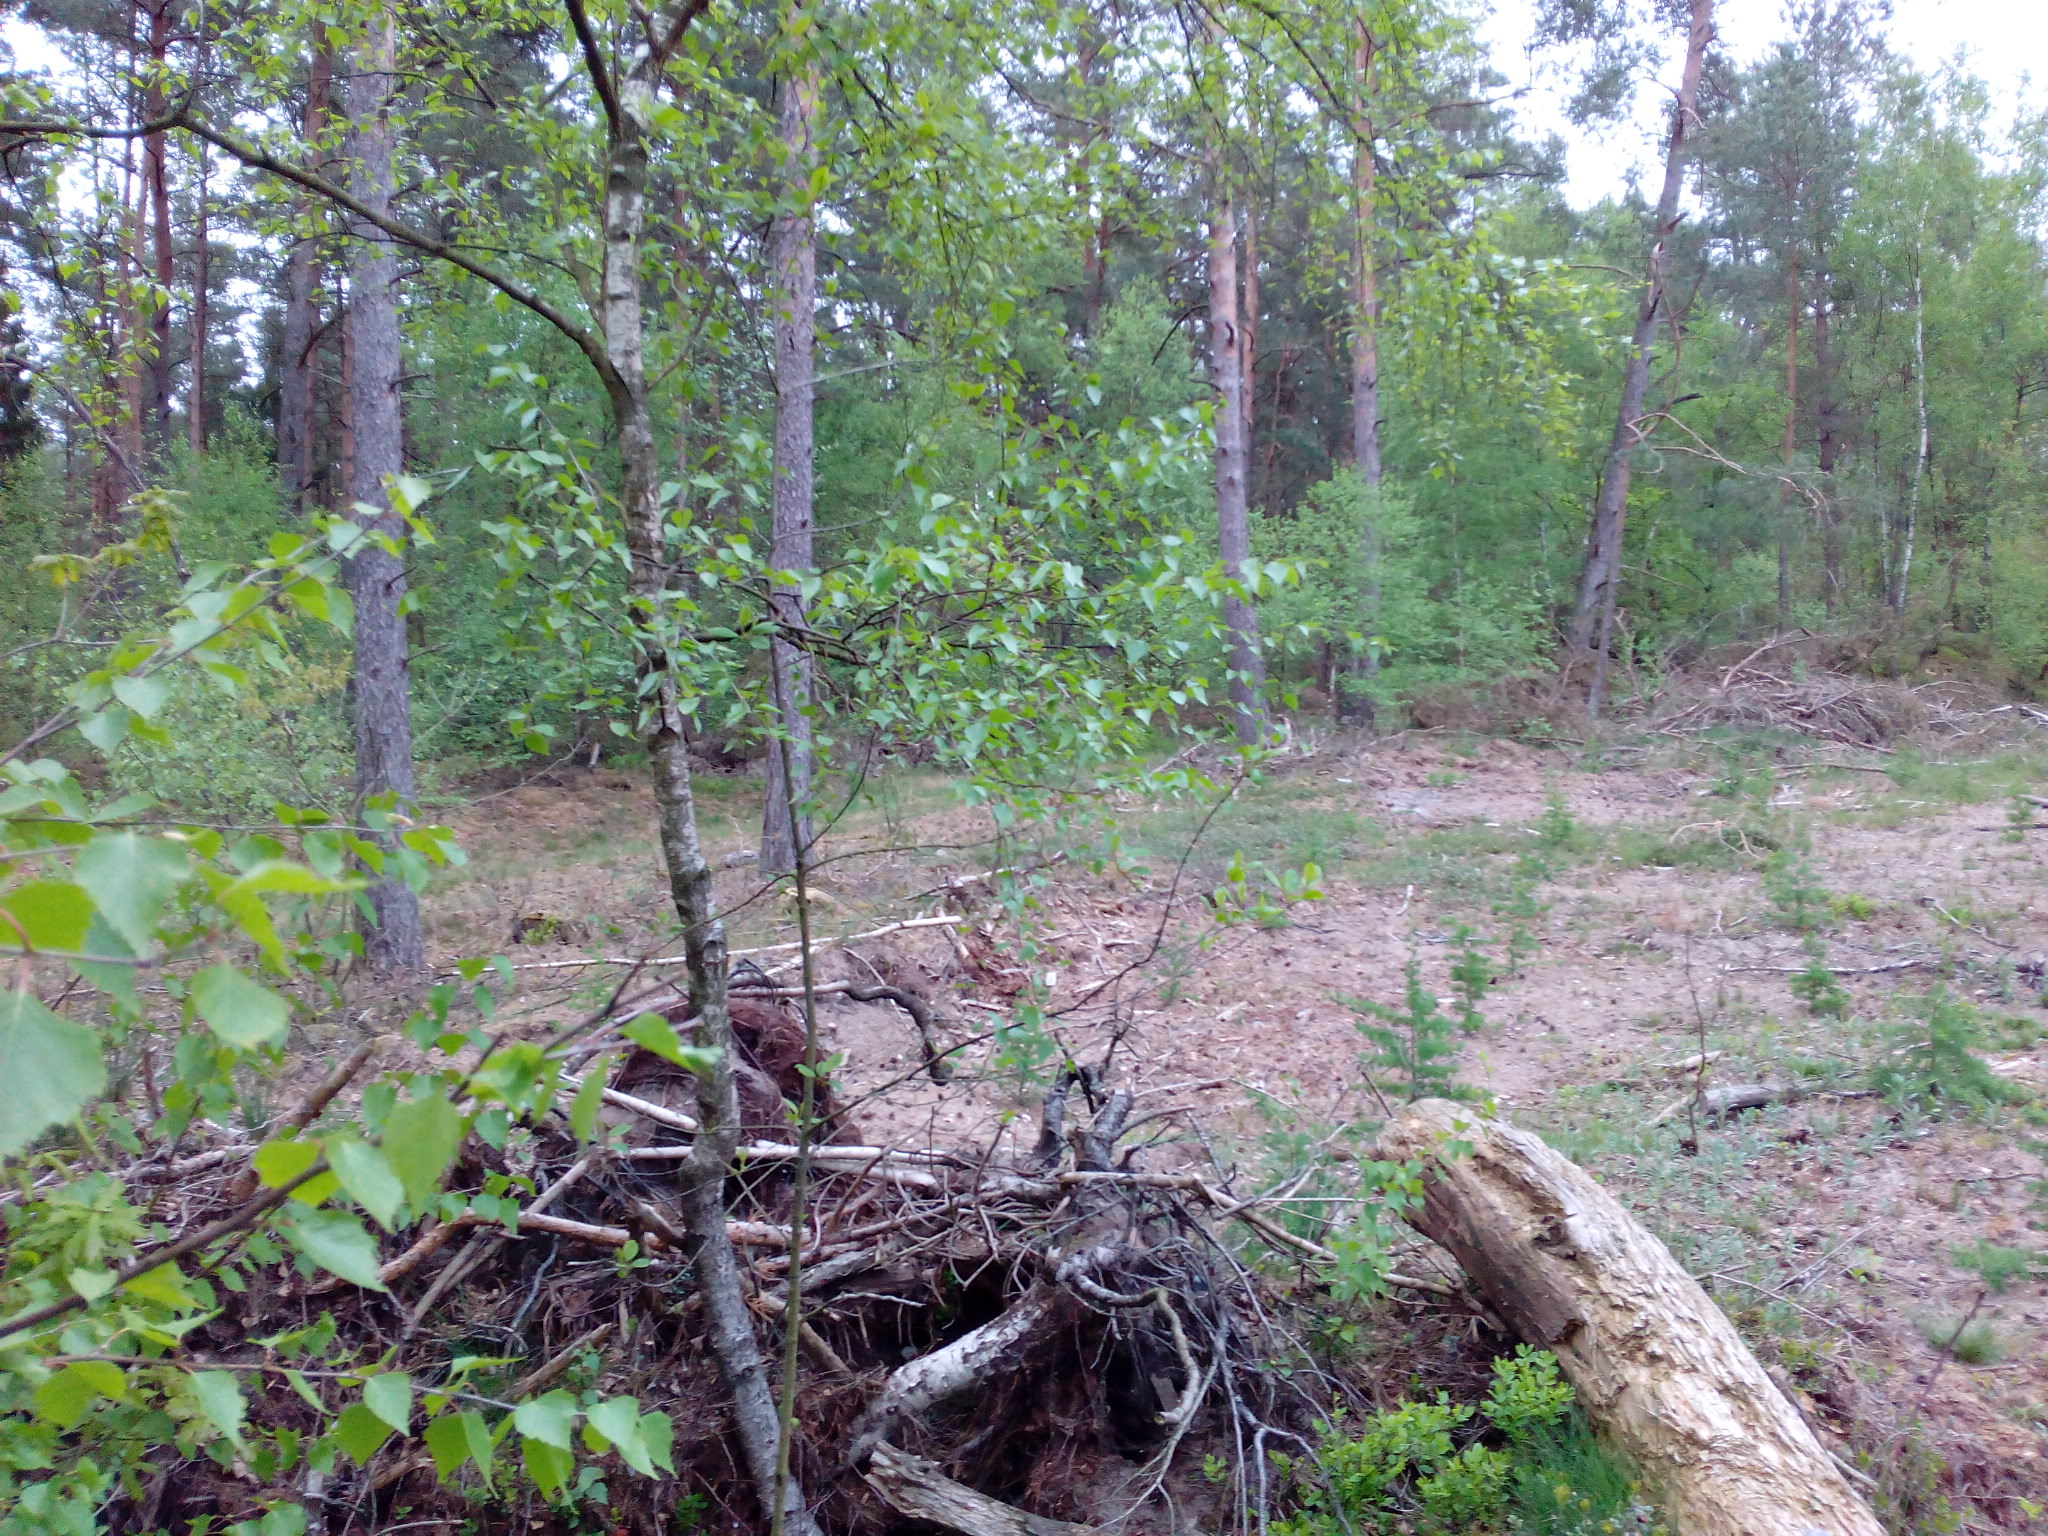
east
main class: Woodland
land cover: Pine dominated mixed woodland
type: hemiboreal forest and nemoral coniferous forest and mixed broadleaved-coniferous forest
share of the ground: 50 - 75 %
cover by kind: coniferous forest trees 60 %, broadleaved forest trees 30 %, herbaceous plants 10 %
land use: Forestry
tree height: > 5 m
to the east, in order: Pine dominated mixed woodland; Tracks; Pine dominated mixed woodland
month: May
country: DE
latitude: 52.9706
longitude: 9.9256
